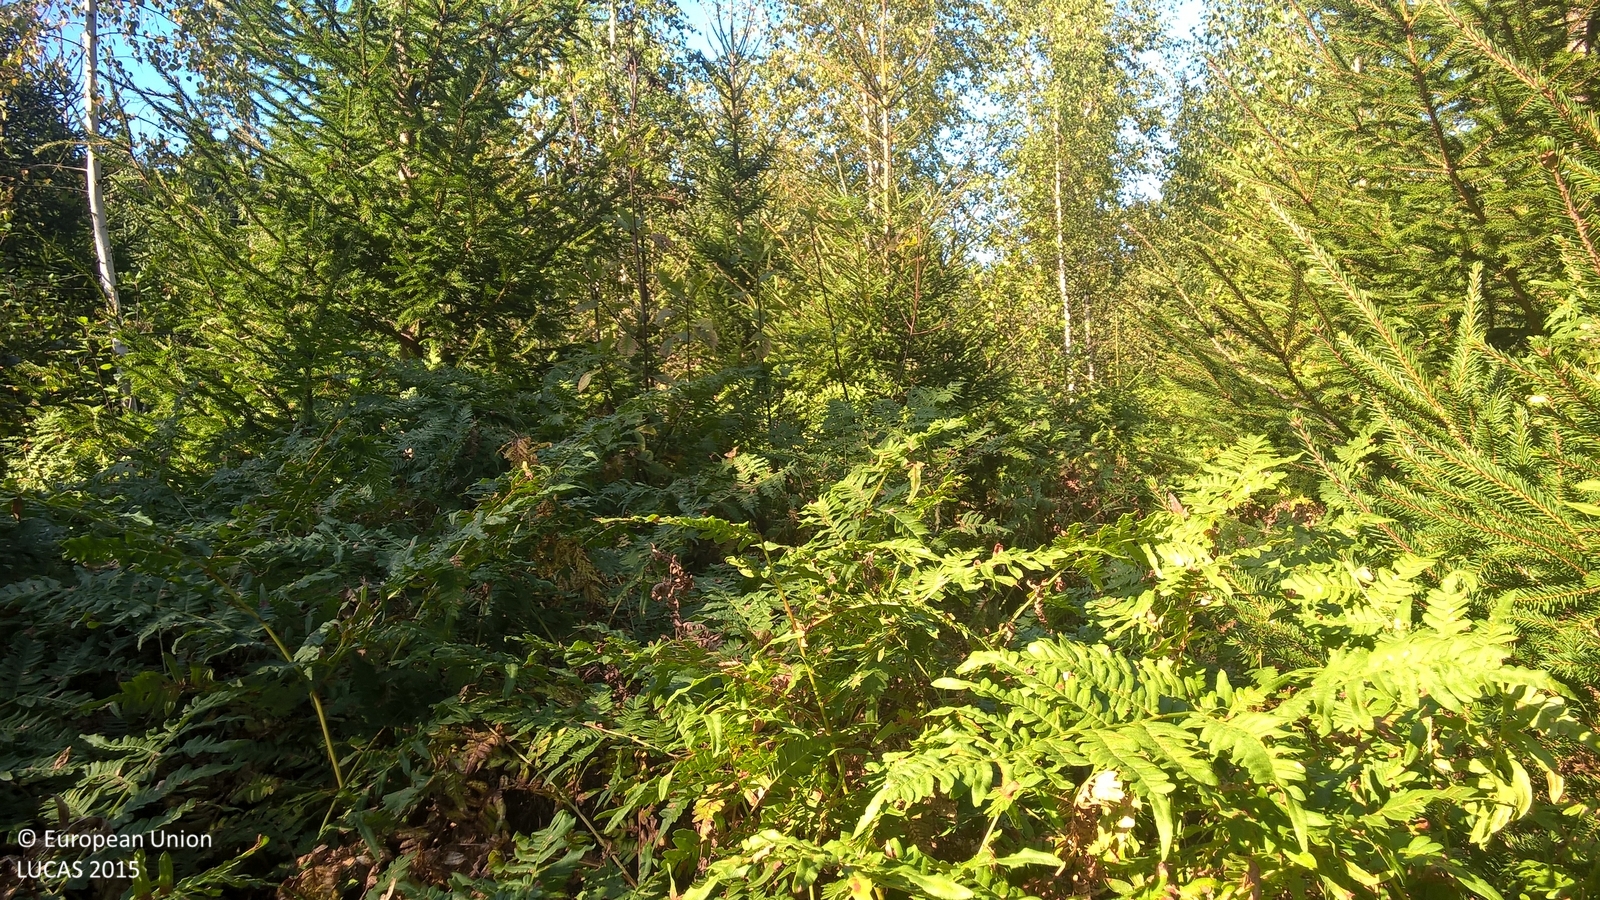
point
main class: Woodland
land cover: Spruce dominated mixed woodland
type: hemiboreal forest and nemoral coniferous forest and mixed broadleaved-coniferous forest
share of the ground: > 75 %
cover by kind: broadleaved forest trees 50 %, coniferous forest trees 30 %, shrubs 10 %, herbaceous plants 10 %
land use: Forestry
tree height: > 5 m
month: September
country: LV
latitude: 57.3948
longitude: 25.5755
